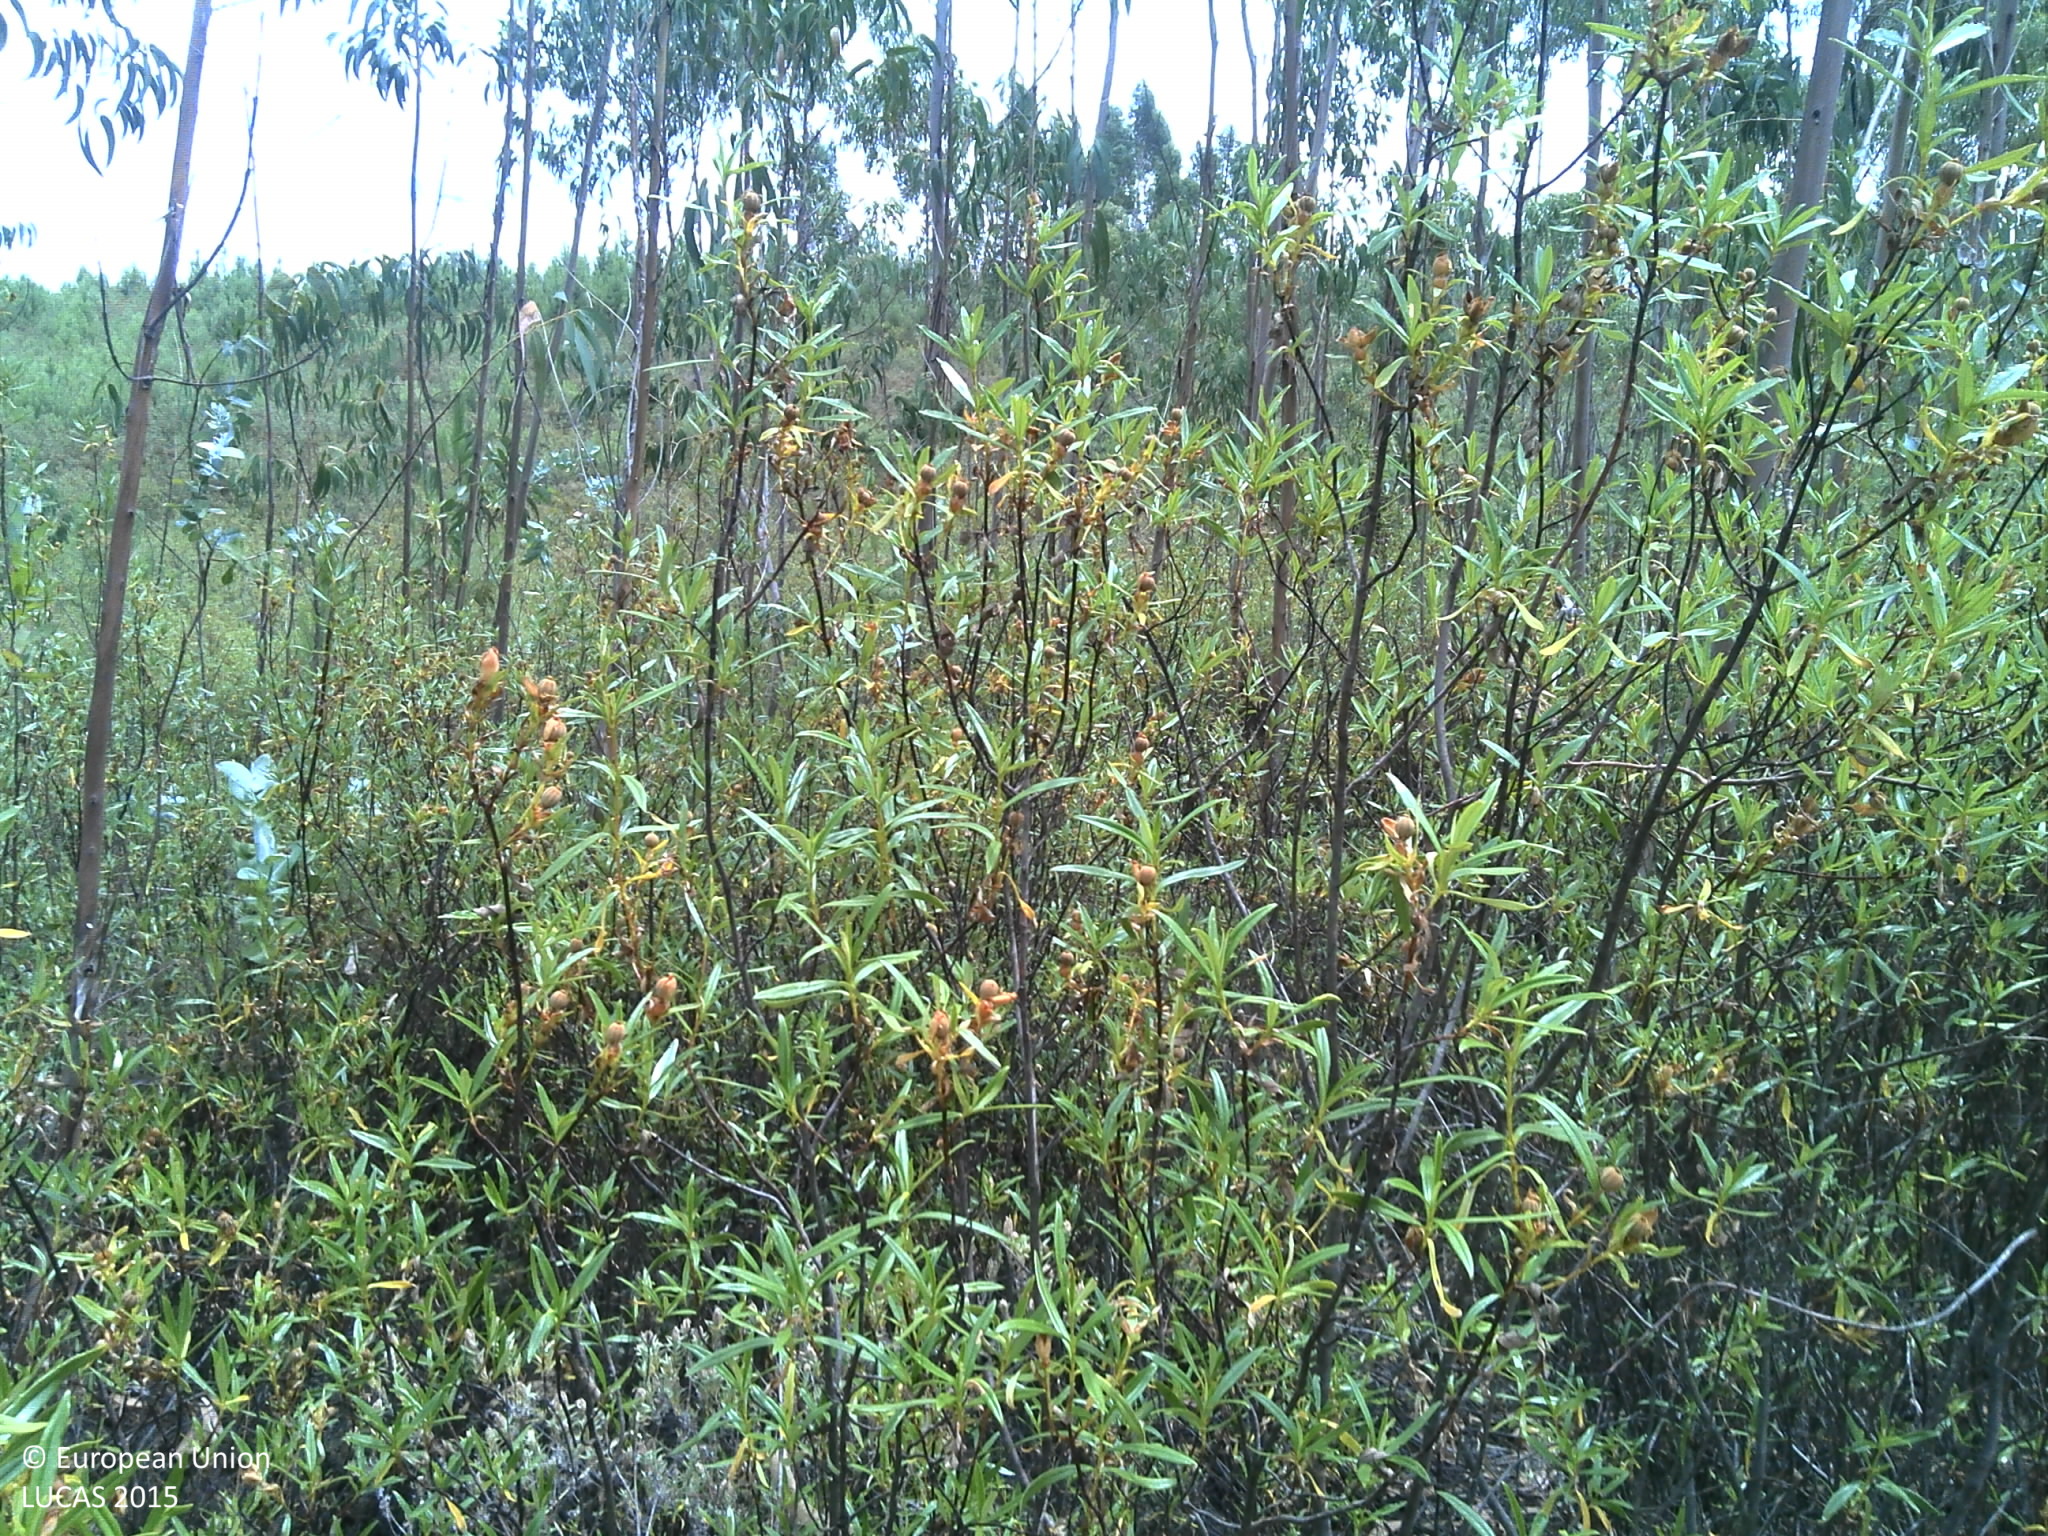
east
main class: Shrubland
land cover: Shrubland with sparse tree cover
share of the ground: > 75 %
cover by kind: shrubs 85 %, broadleaved forest trees 5 %, consolidated bare surface 5 %, unconsolidated bare surface 5 %
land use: Abandoned areas
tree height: > 5 m
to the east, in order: Shrubland with sparse tree cover; Shrubland without tree cover; Shrubland with sparse tree cover; Shrubland without tree cover; Tracks; Shrubland with sparse tree cover; Broadleaved woodland; Pine dominated coniferous woodland; Tracks; Pine dominated coniferous woodland
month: July
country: PT
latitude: 39.5674
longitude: -8.0935
